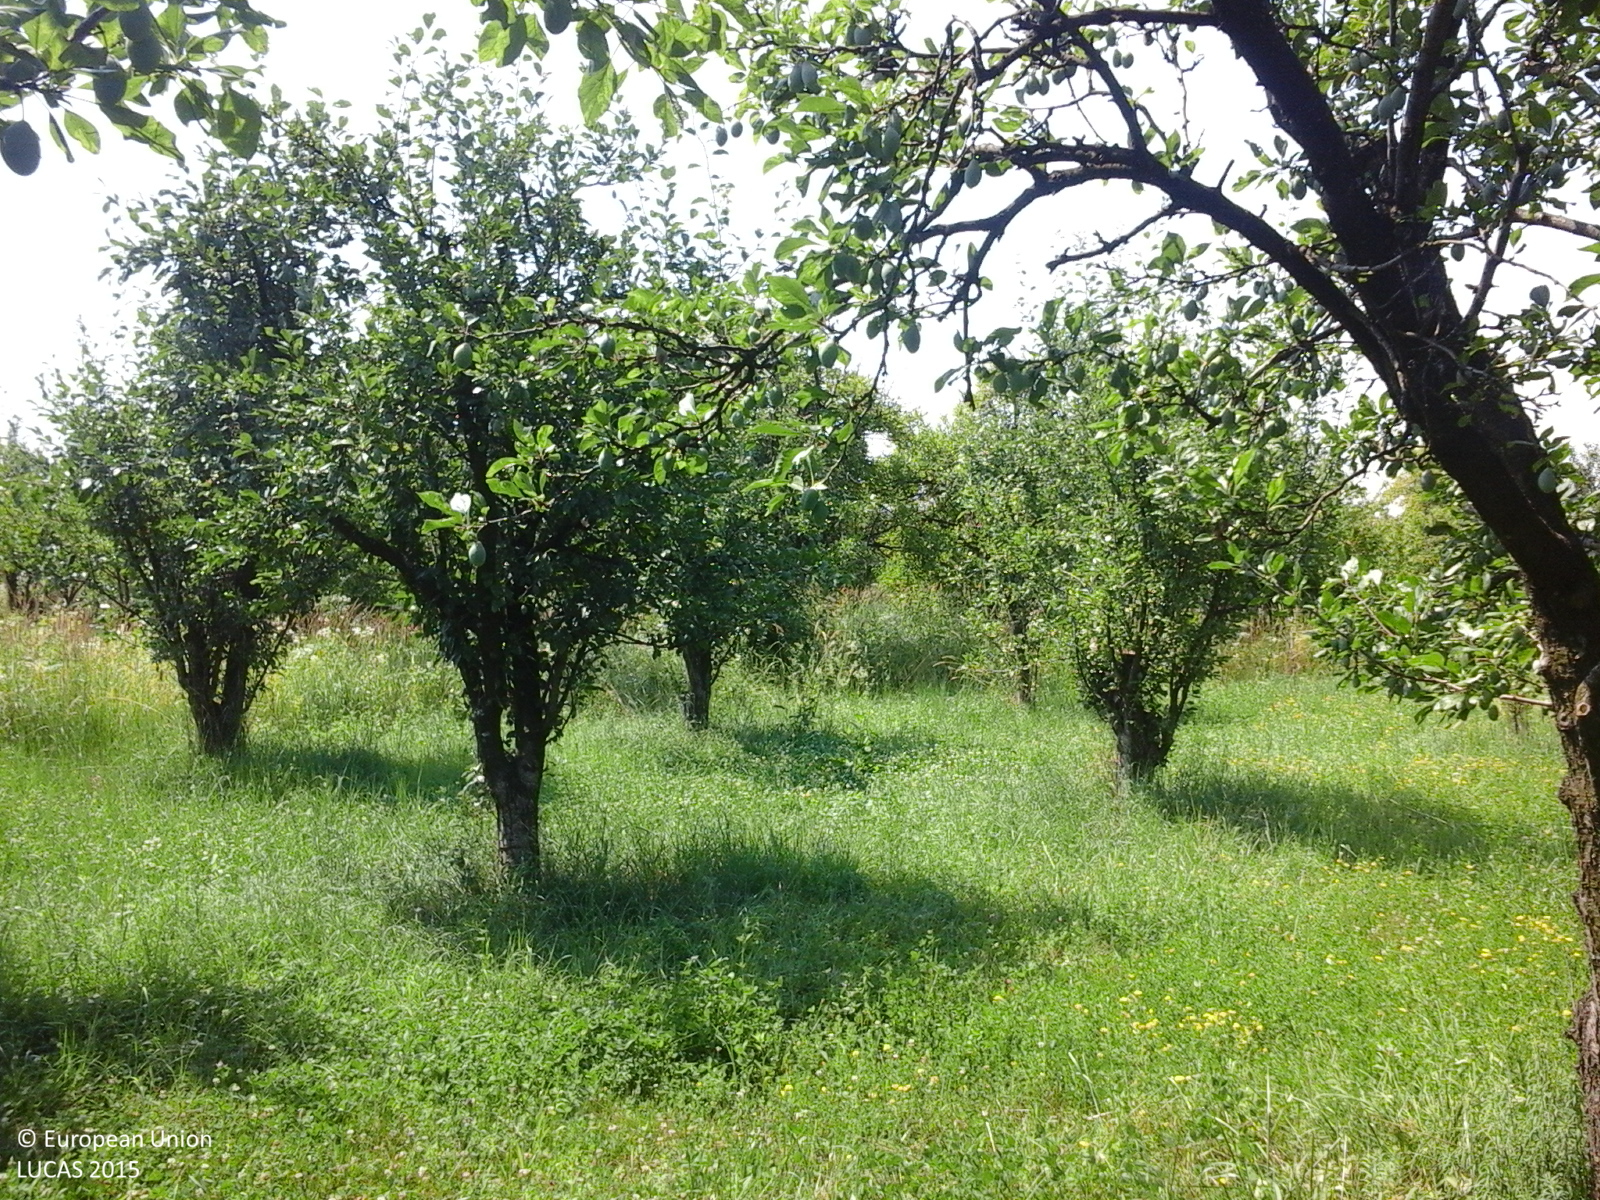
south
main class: Cropland
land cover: Other fruit trees and berries
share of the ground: > 75 %
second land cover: Grassland without tree/shrub cover
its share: 25 - 50 %
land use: Agriculture (excluding fallow land and kitchen gardens)
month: July
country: RO
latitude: 44.8333
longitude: 25.4629
